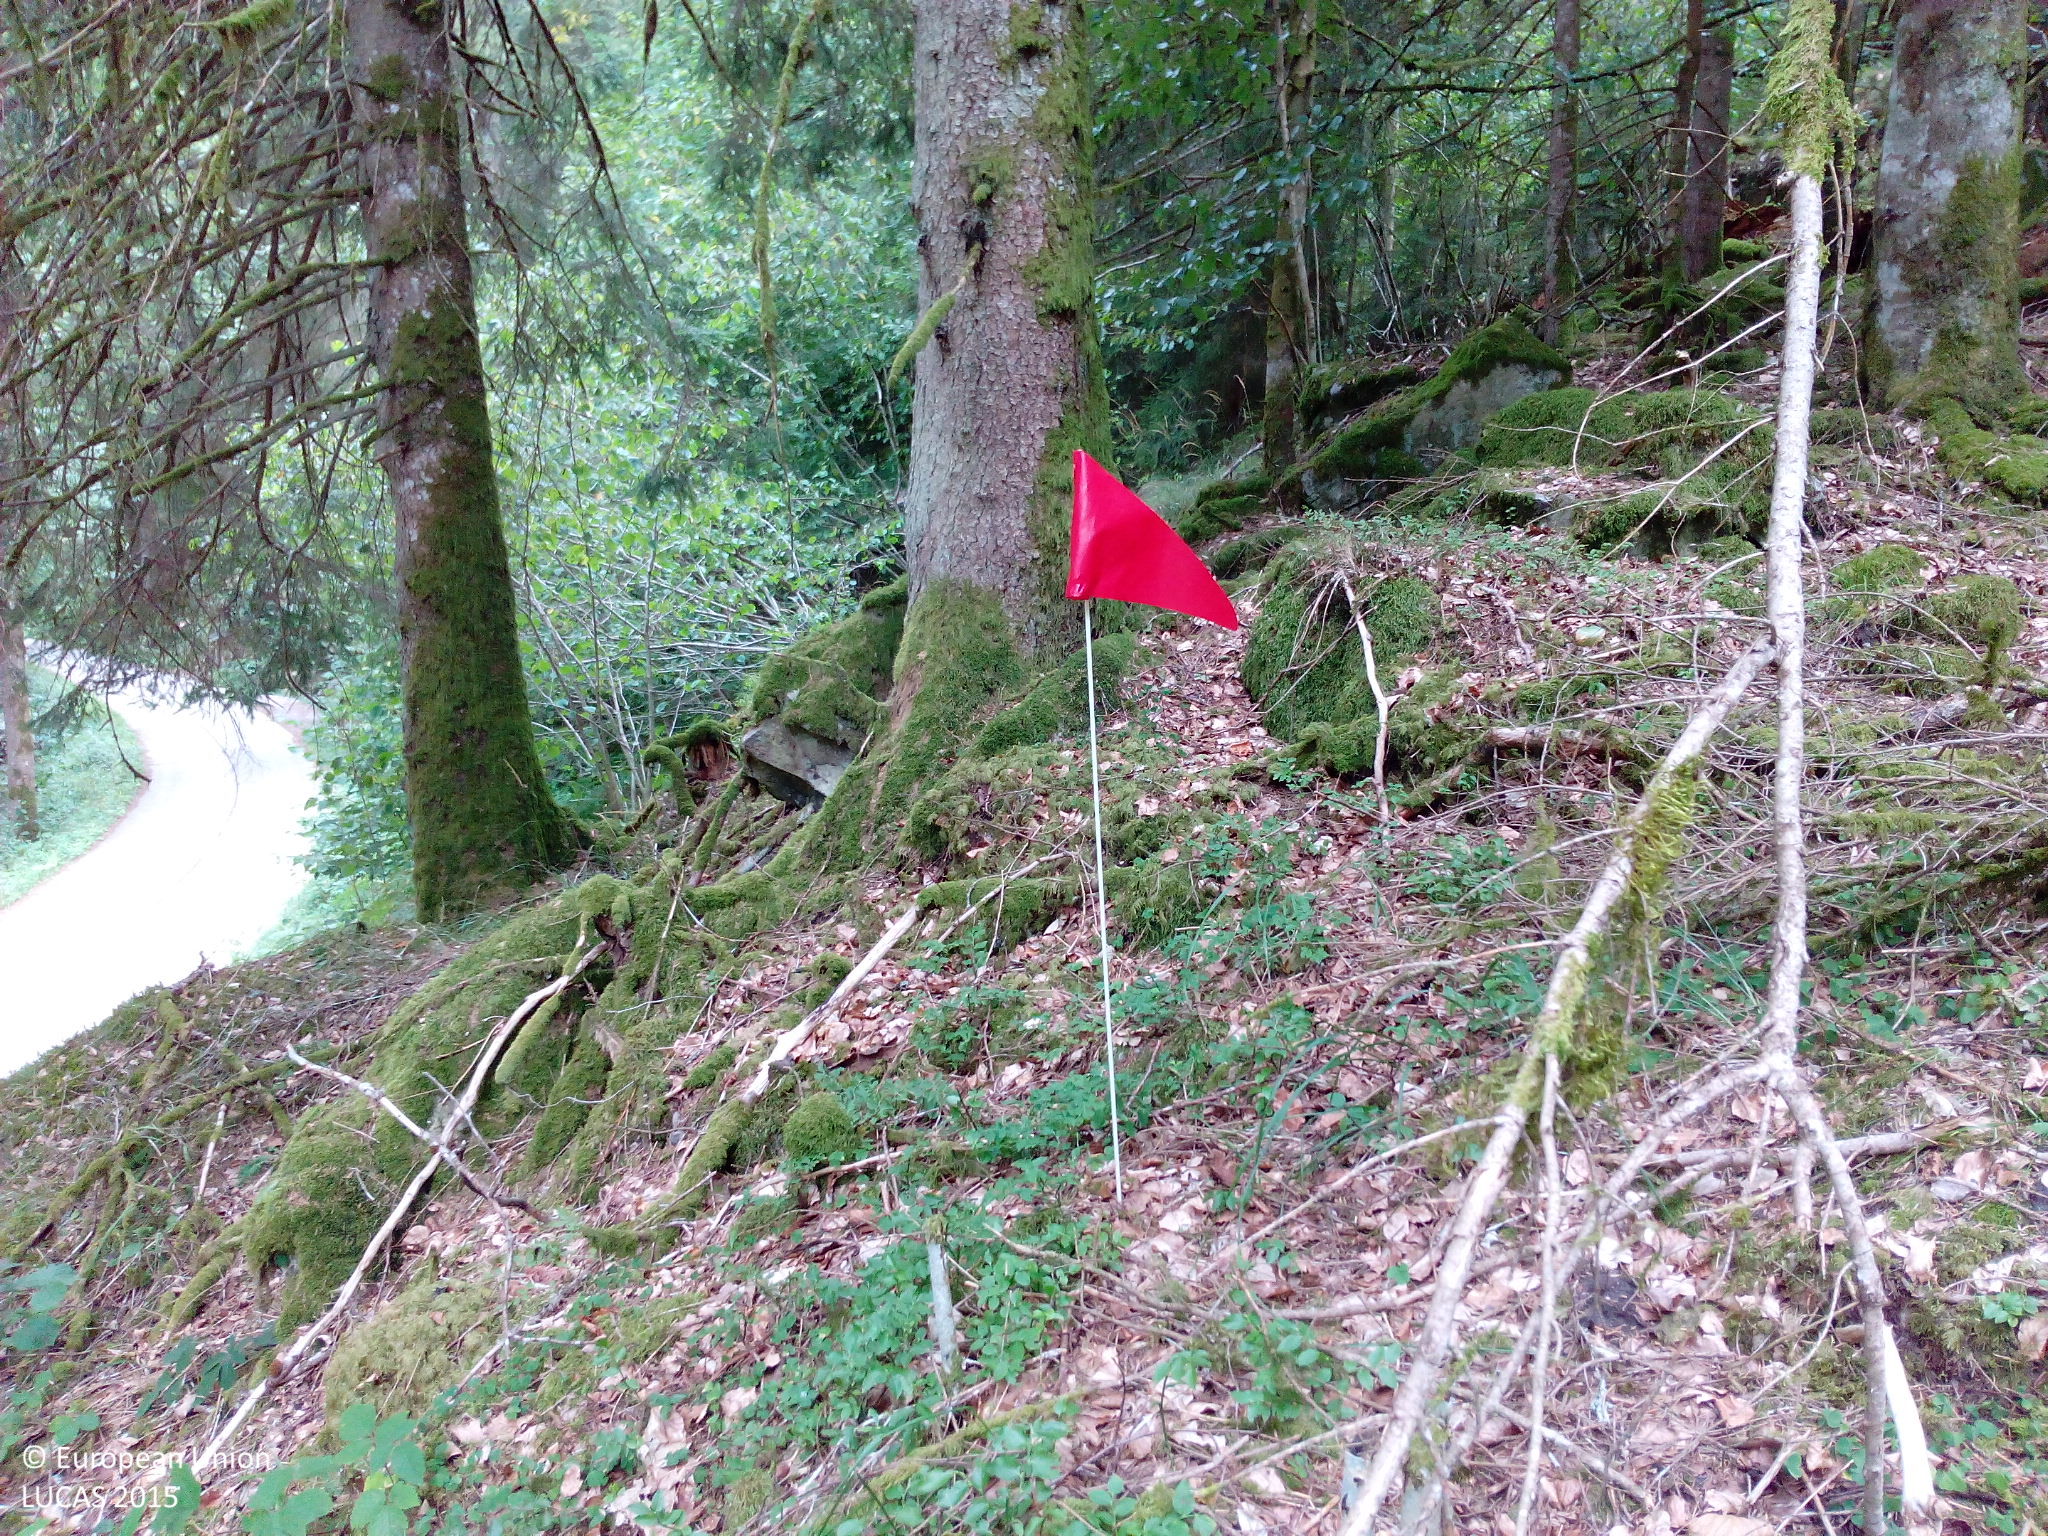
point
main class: Woodland
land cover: Spruce dominated mixed woodland
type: mesophytic deciduous forest
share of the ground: > 75 %
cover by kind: coniferous forest trees 50 %, broadleaved forest trees 25 %, lichens and mosses 10 %, shrubs 5 %, herbaceous plants 5 %, unconsolidated bare surface 5 %
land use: Forestry
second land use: Amenities, museums, leisure
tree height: > 5 m
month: August
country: DE
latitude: 47.7408
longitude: 8.2009
